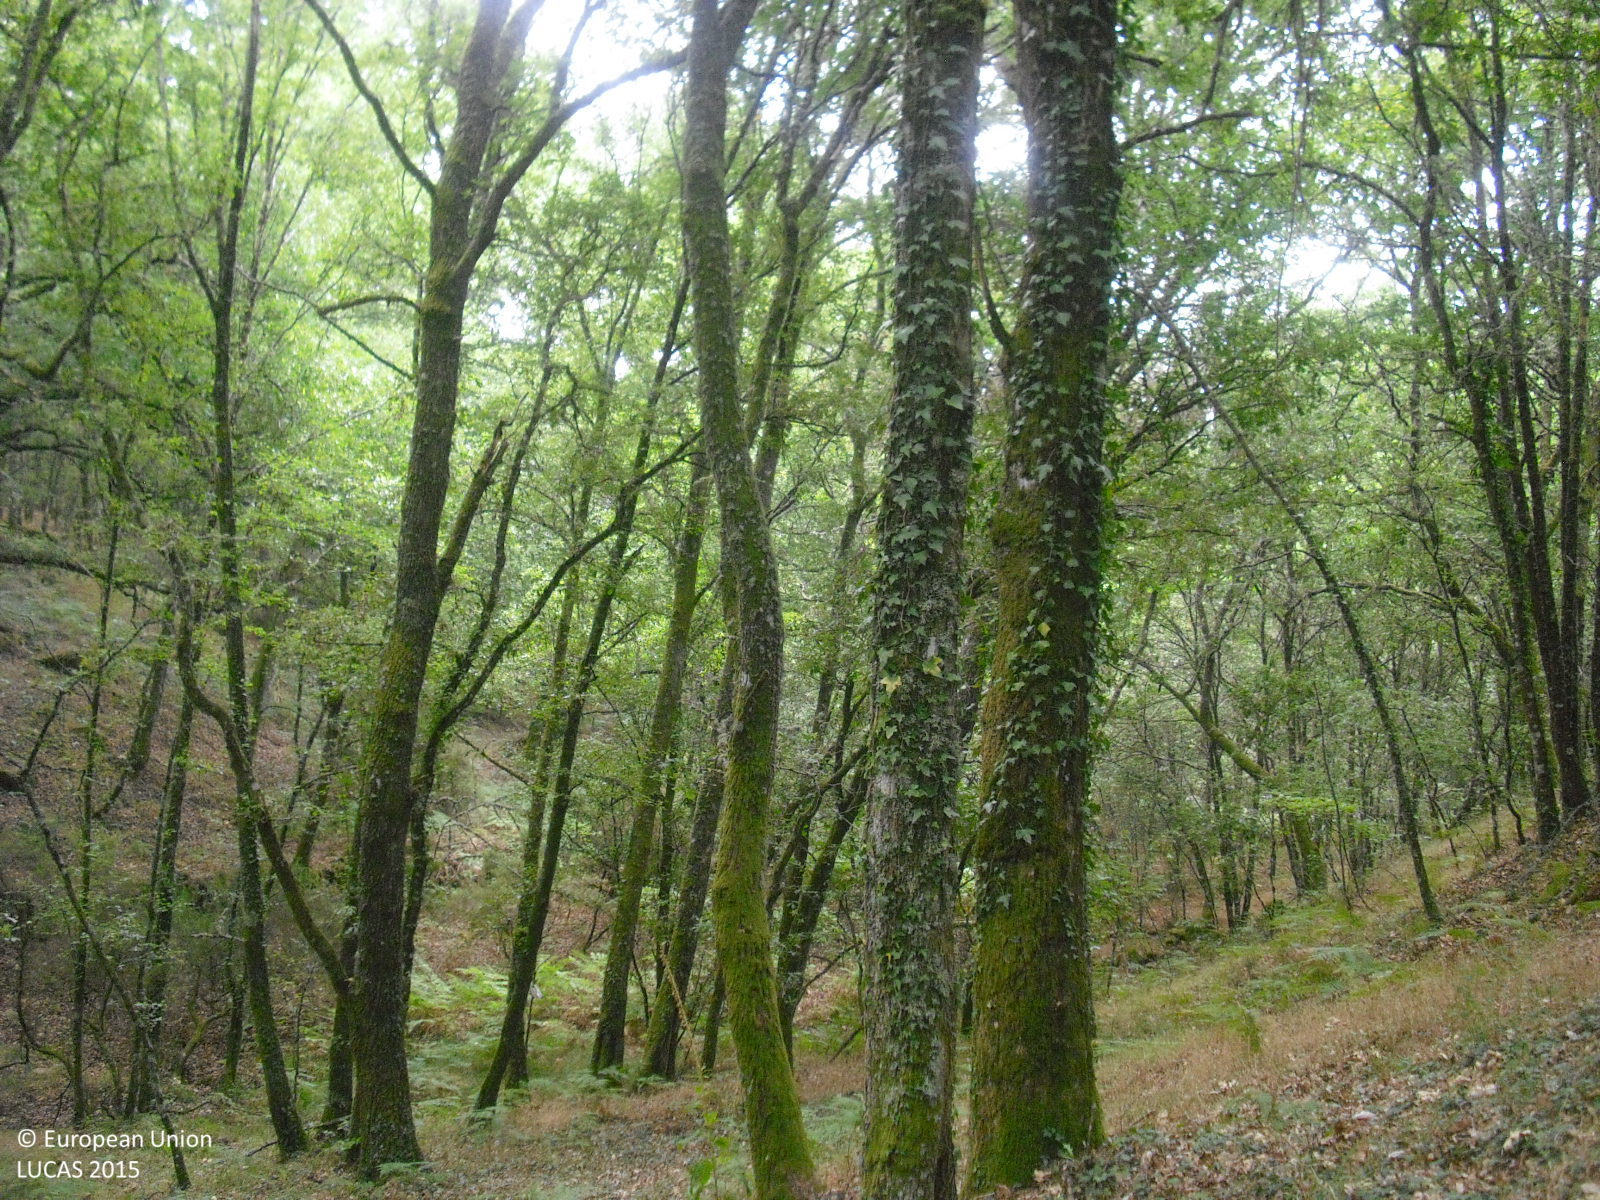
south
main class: Woodland
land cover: Broadleaved woodland
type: thermophilous deciduous forest
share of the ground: > 75 %
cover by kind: broadleaved forest trees 90 %, shrubs 10 %
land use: Forestry
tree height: > 5 m
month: July
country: ES
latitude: 42.3901
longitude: -7.6989
